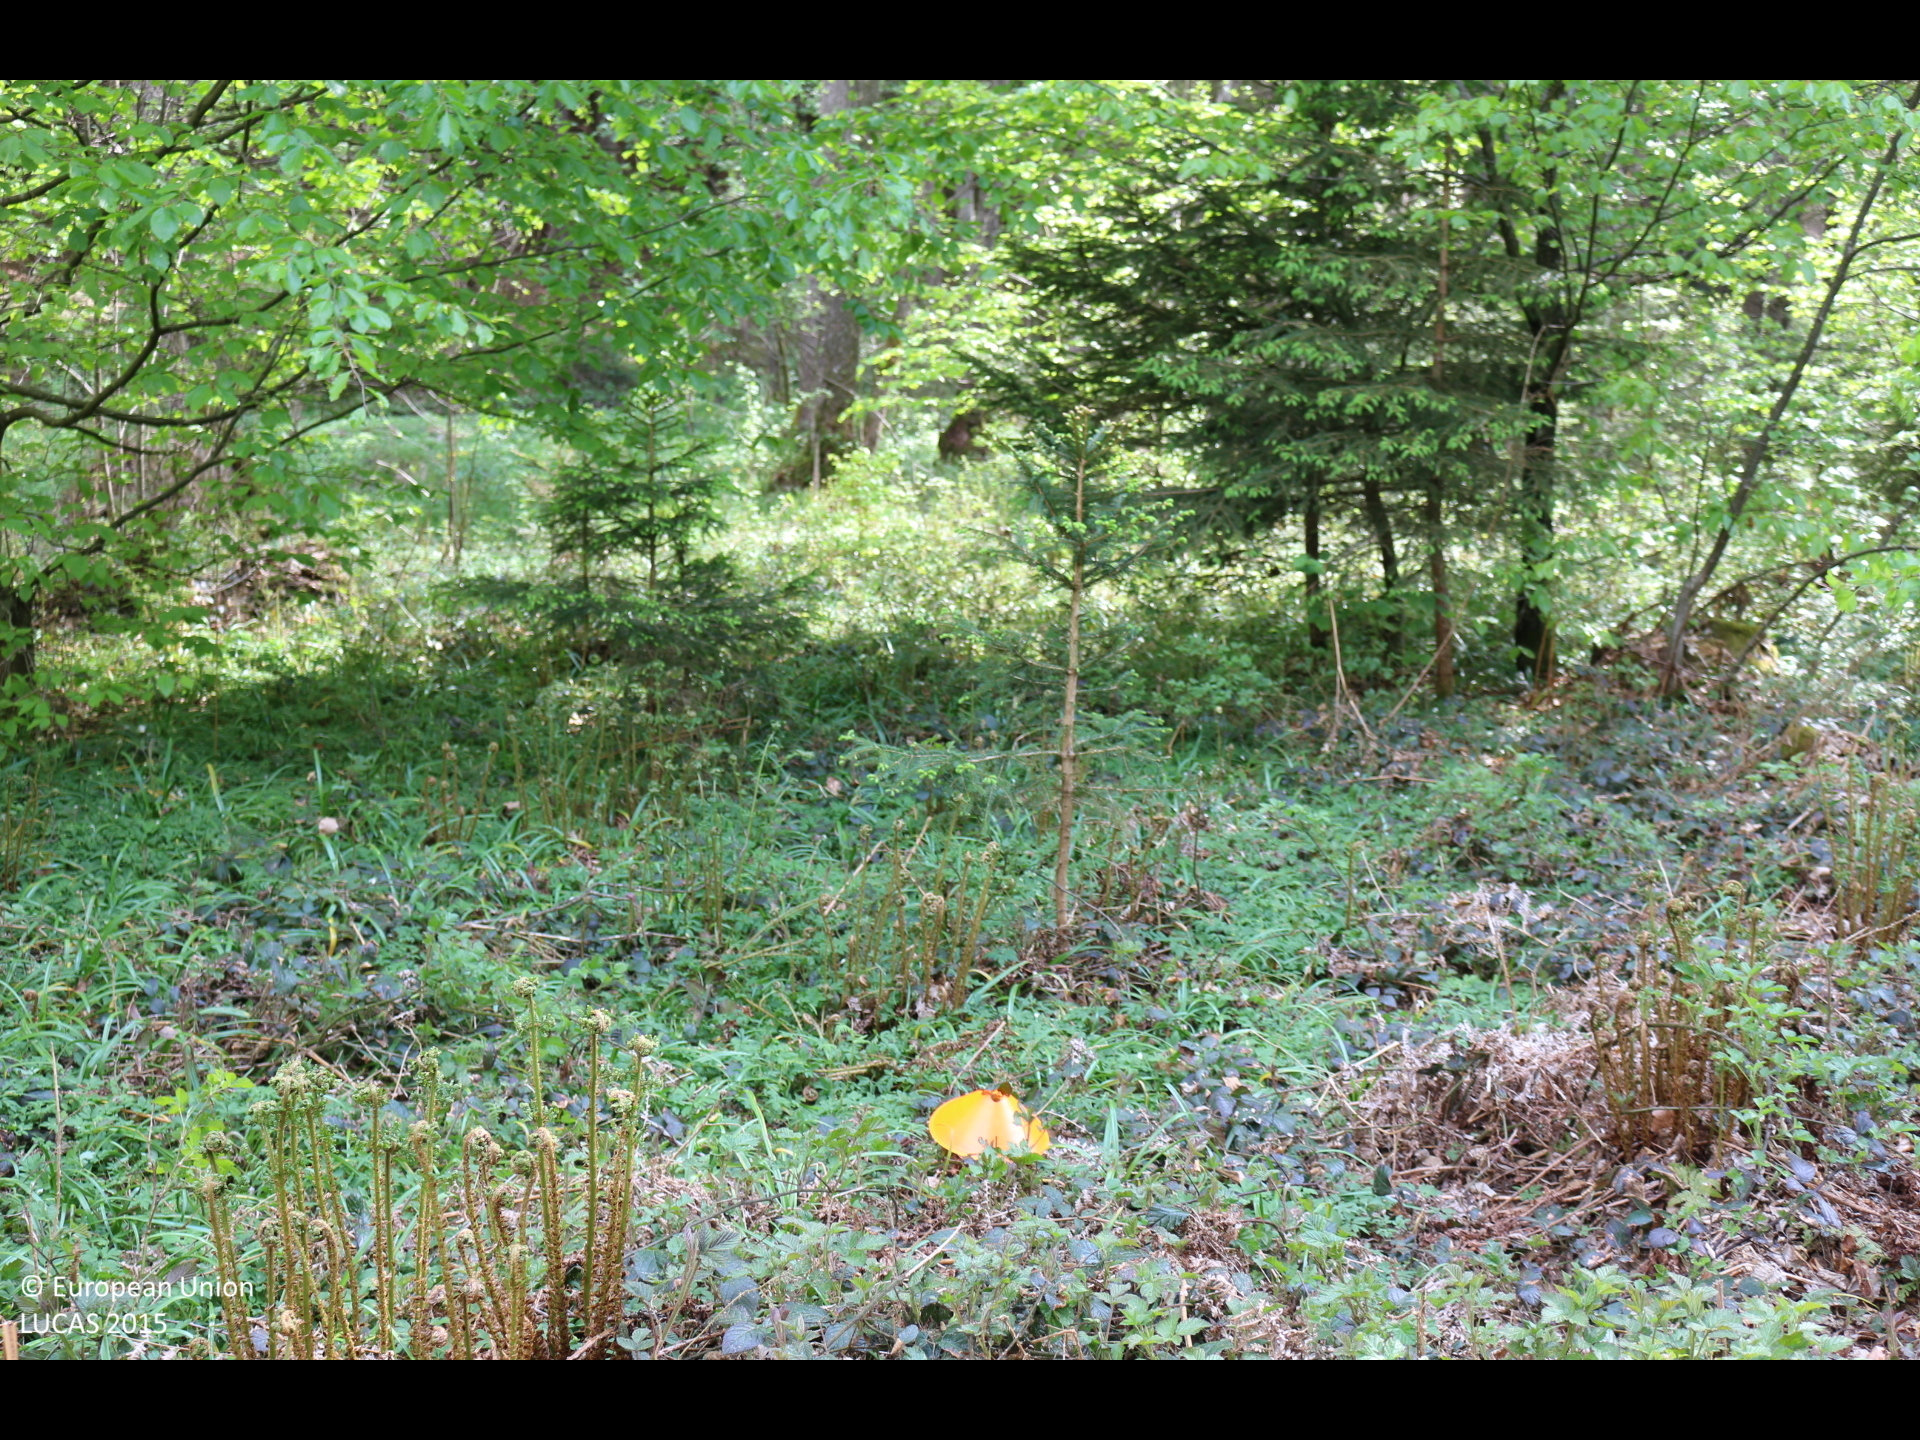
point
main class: Woodland
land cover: Spruce dominated mixed woodland
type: mountainous beech forest
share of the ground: > 75 %
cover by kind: broadleaved forest trees 50 %, coniferous forest trees 40 %, shrubs 10 %
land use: Forestry
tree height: > 5 m
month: May
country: AT
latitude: 46.6468
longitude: 14.2176
